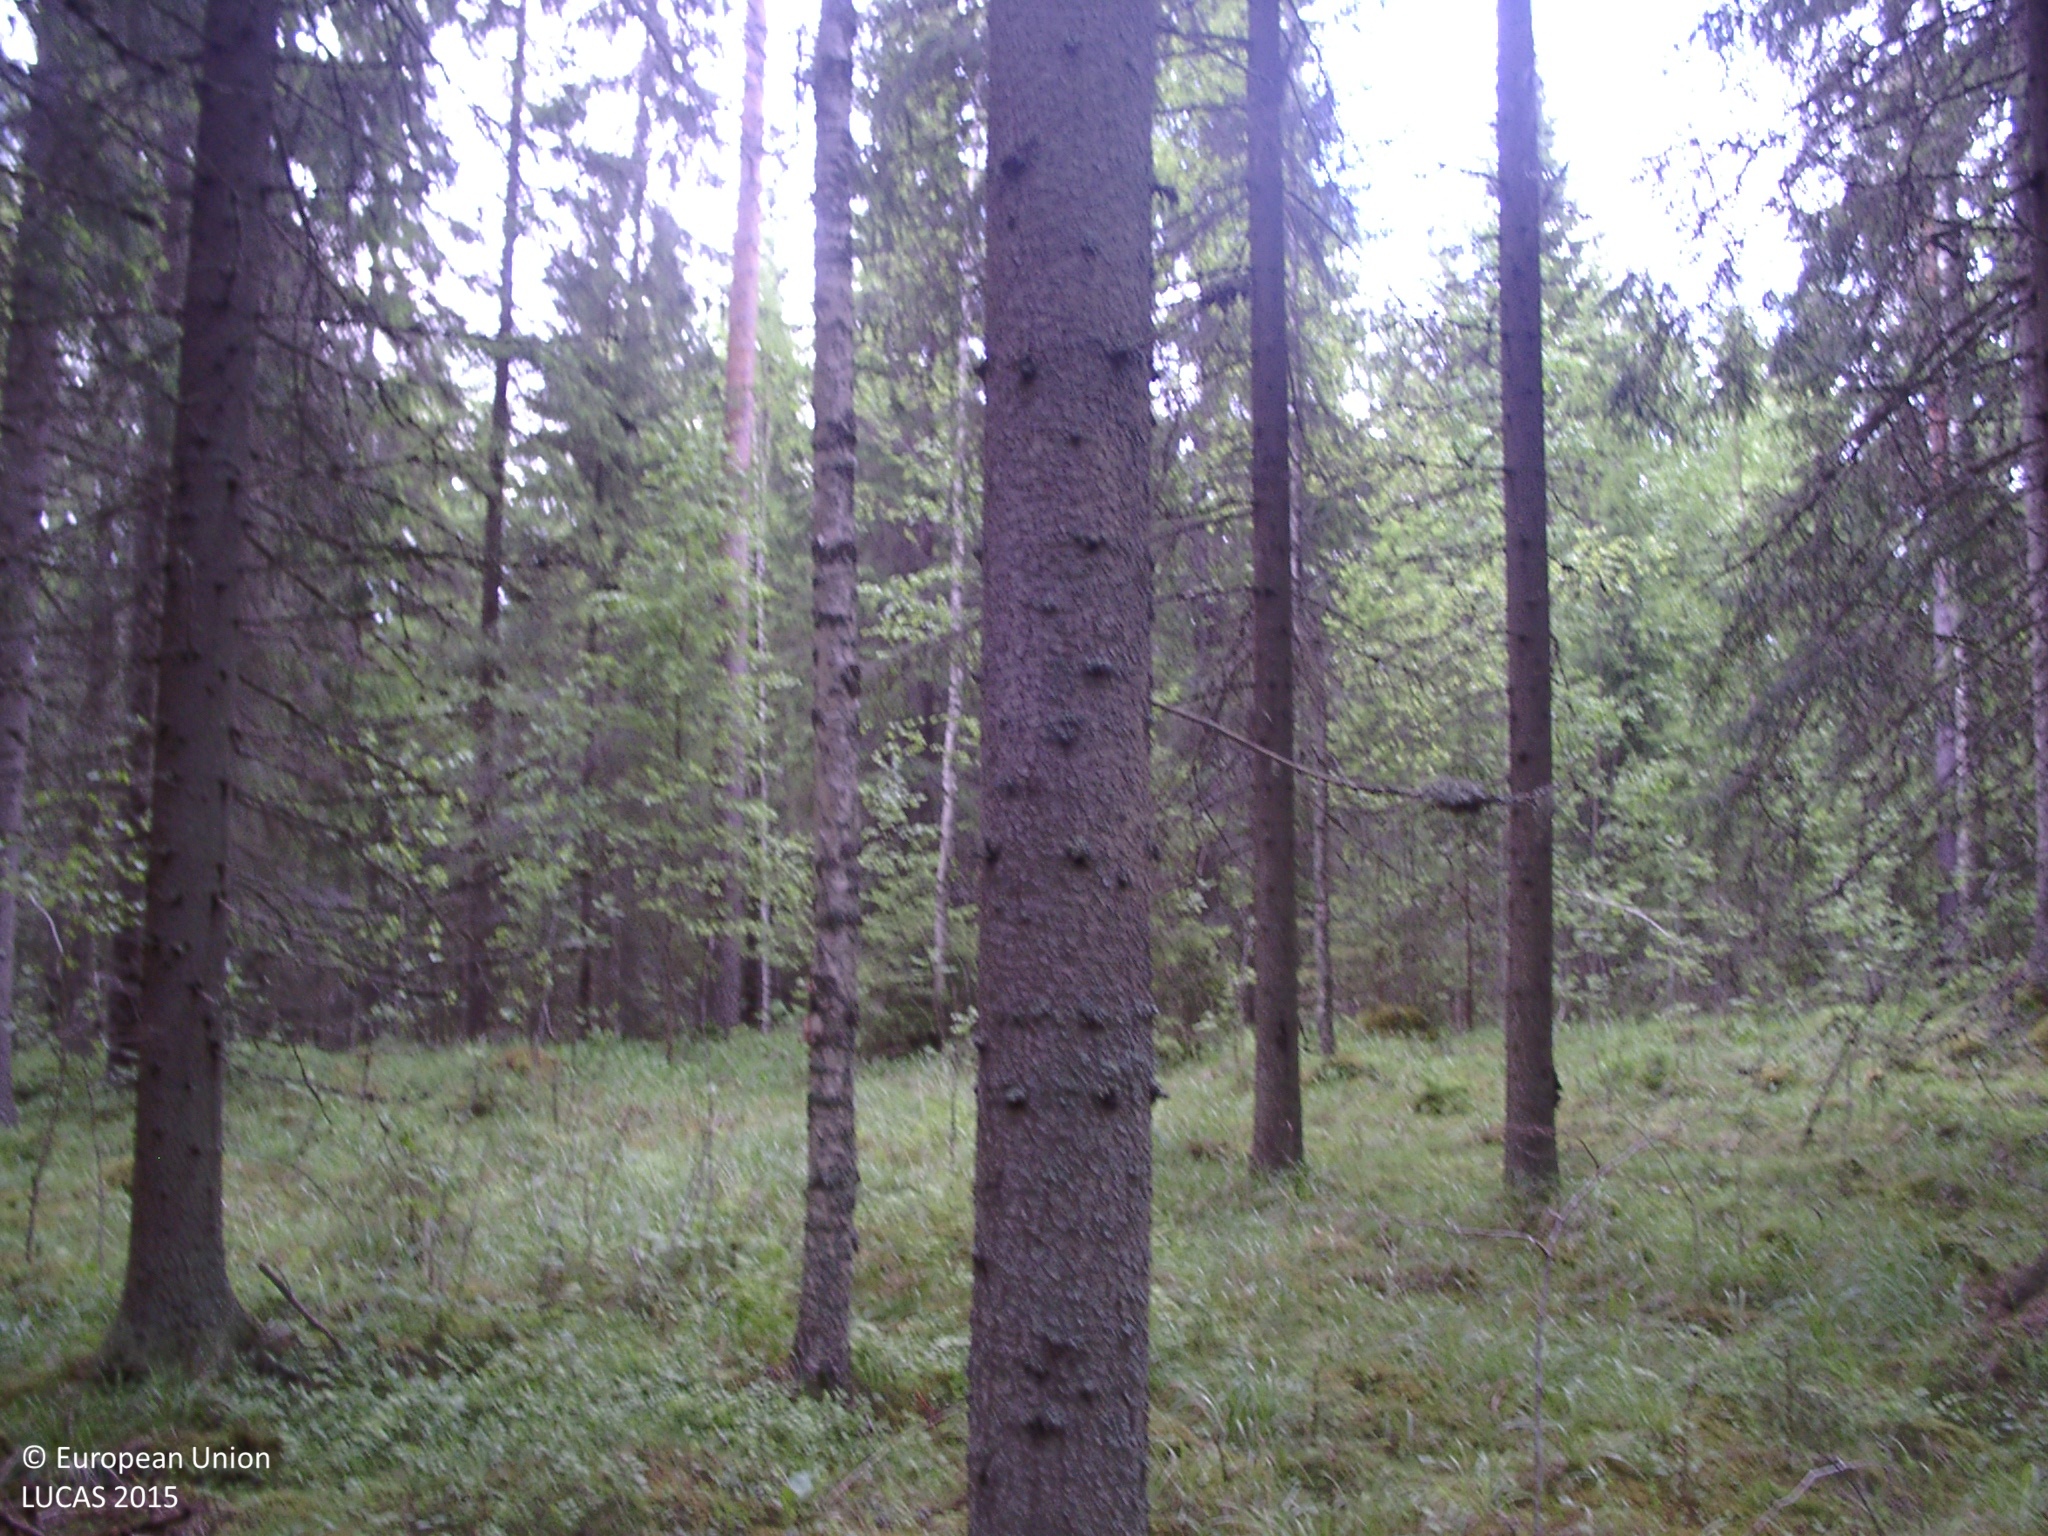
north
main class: Woodland
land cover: Spruce dominated coniferous woodland
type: boreal forest
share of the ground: 50 - 75 %
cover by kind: coniferous forest trees 65 %, herbaceous plants 15 %, lichens and mosses 10 %, broadleaved forest trees 5 %, shrubs 5 %
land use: Forestry
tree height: > 5 m
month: June
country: FI
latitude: 61.6143
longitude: 24.8311
